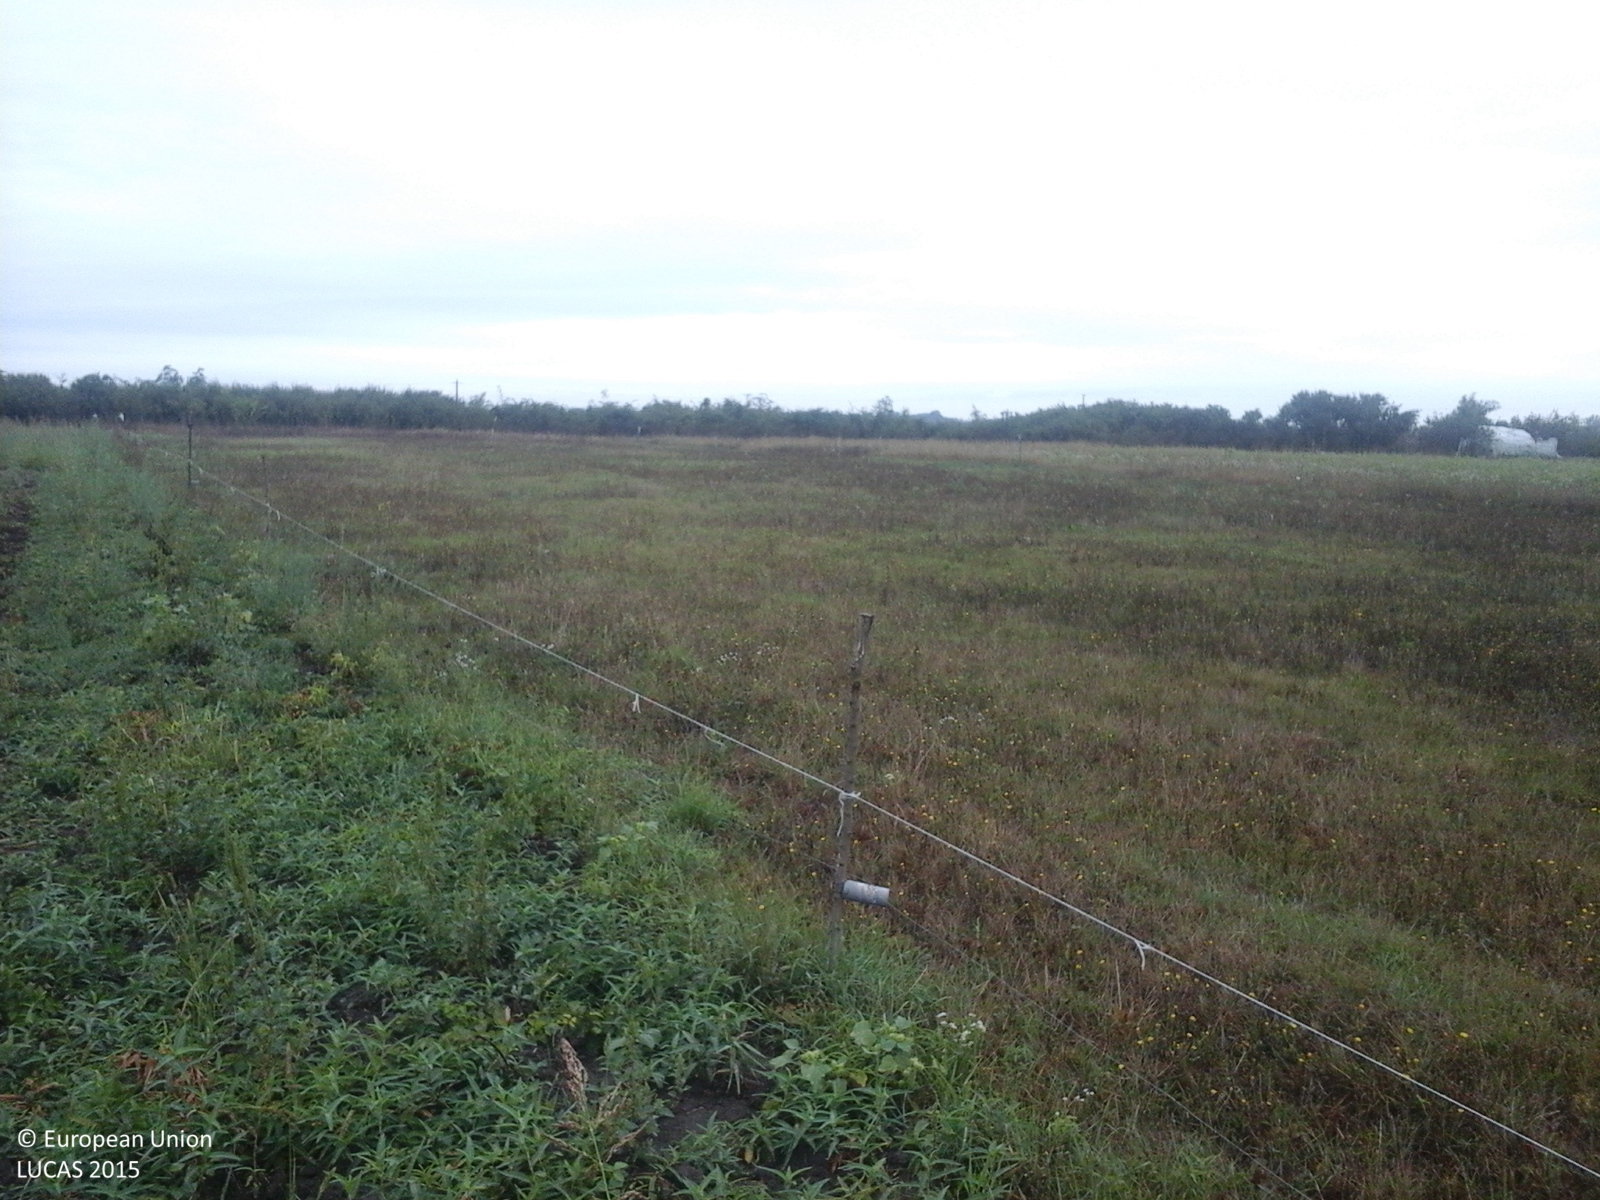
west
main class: Grassland
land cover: Spontaneously vegetated surfaces
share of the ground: > 75 %
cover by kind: herbaceous plants 100 %
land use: Agriculture (excluding fallow land and kitchen gardens)
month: September
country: RO
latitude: 47.2343
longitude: 21.8683
